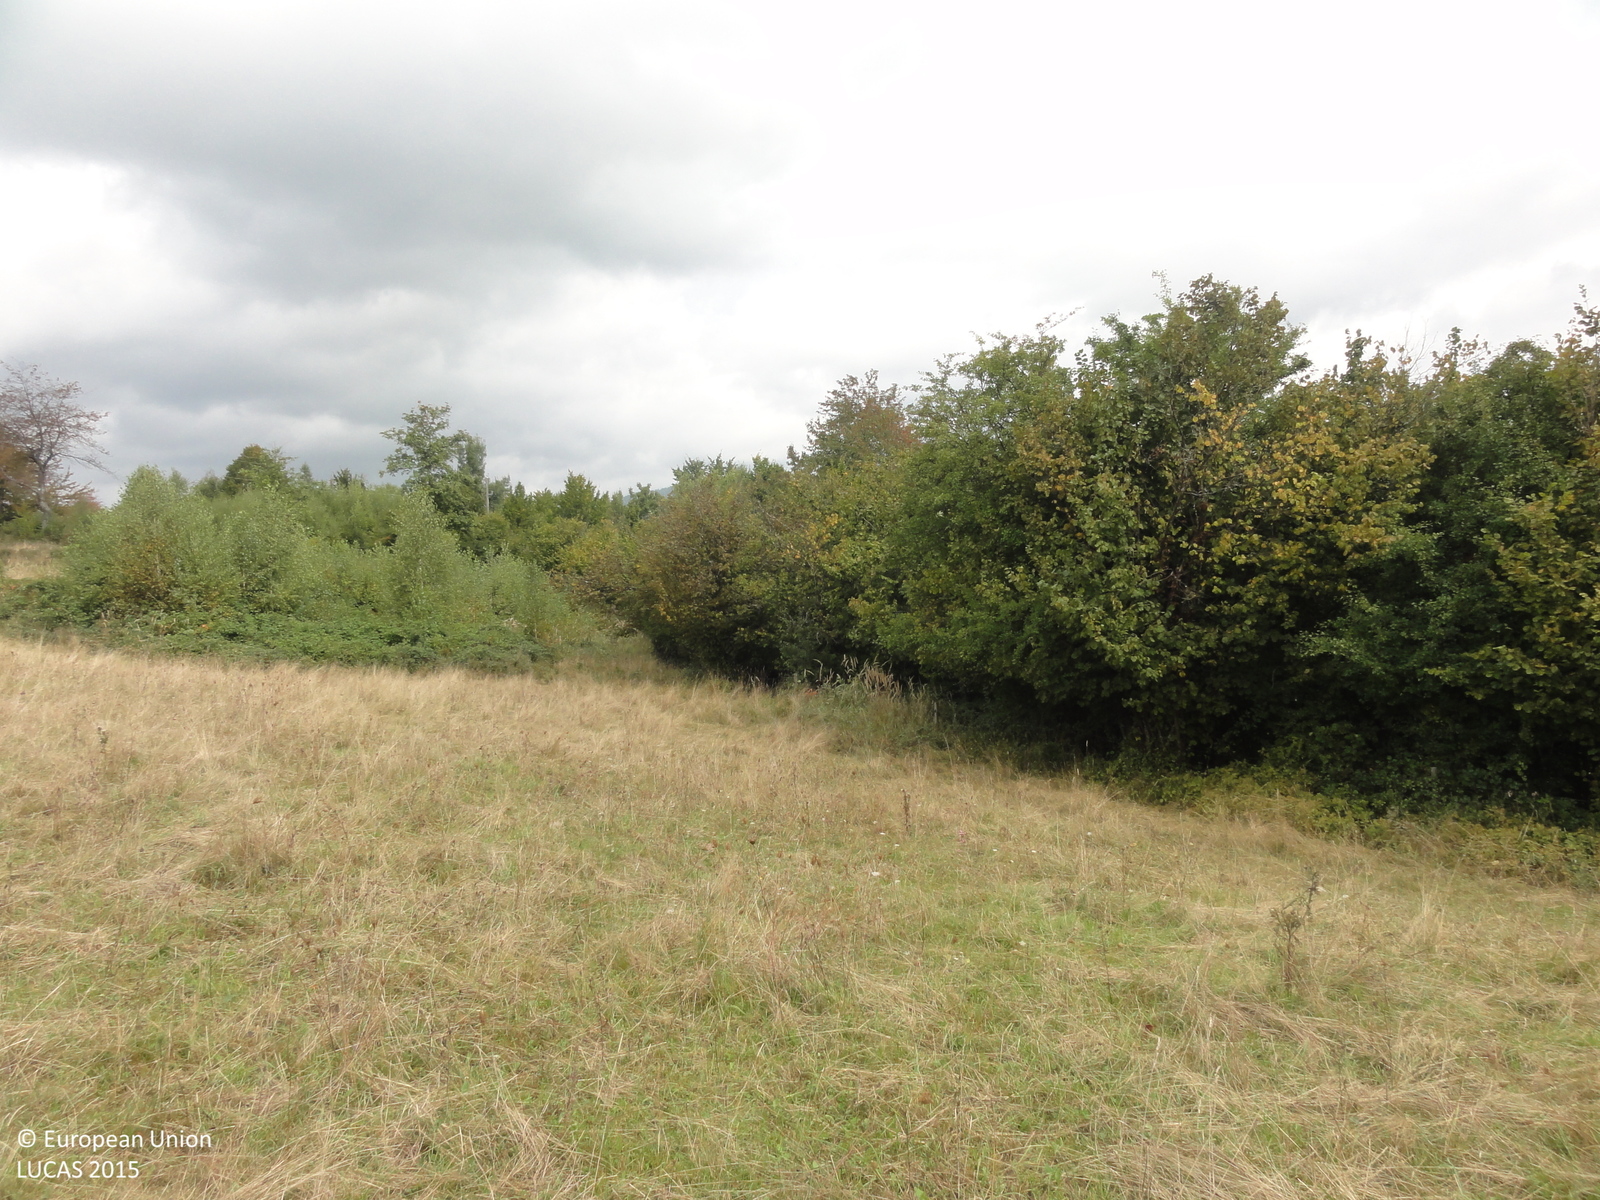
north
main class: Grassland
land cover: Grassland with sparse tree/shrub cover
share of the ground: > 75 %
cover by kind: herbaceous plants 90 %, broadleaved forest trees 5 %, shrubs 5 %
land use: Agriculture (excluding fallow land and kitchen gardens)
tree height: > 5 m
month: September
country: SI
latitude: 45.5830
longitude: 15.0328
